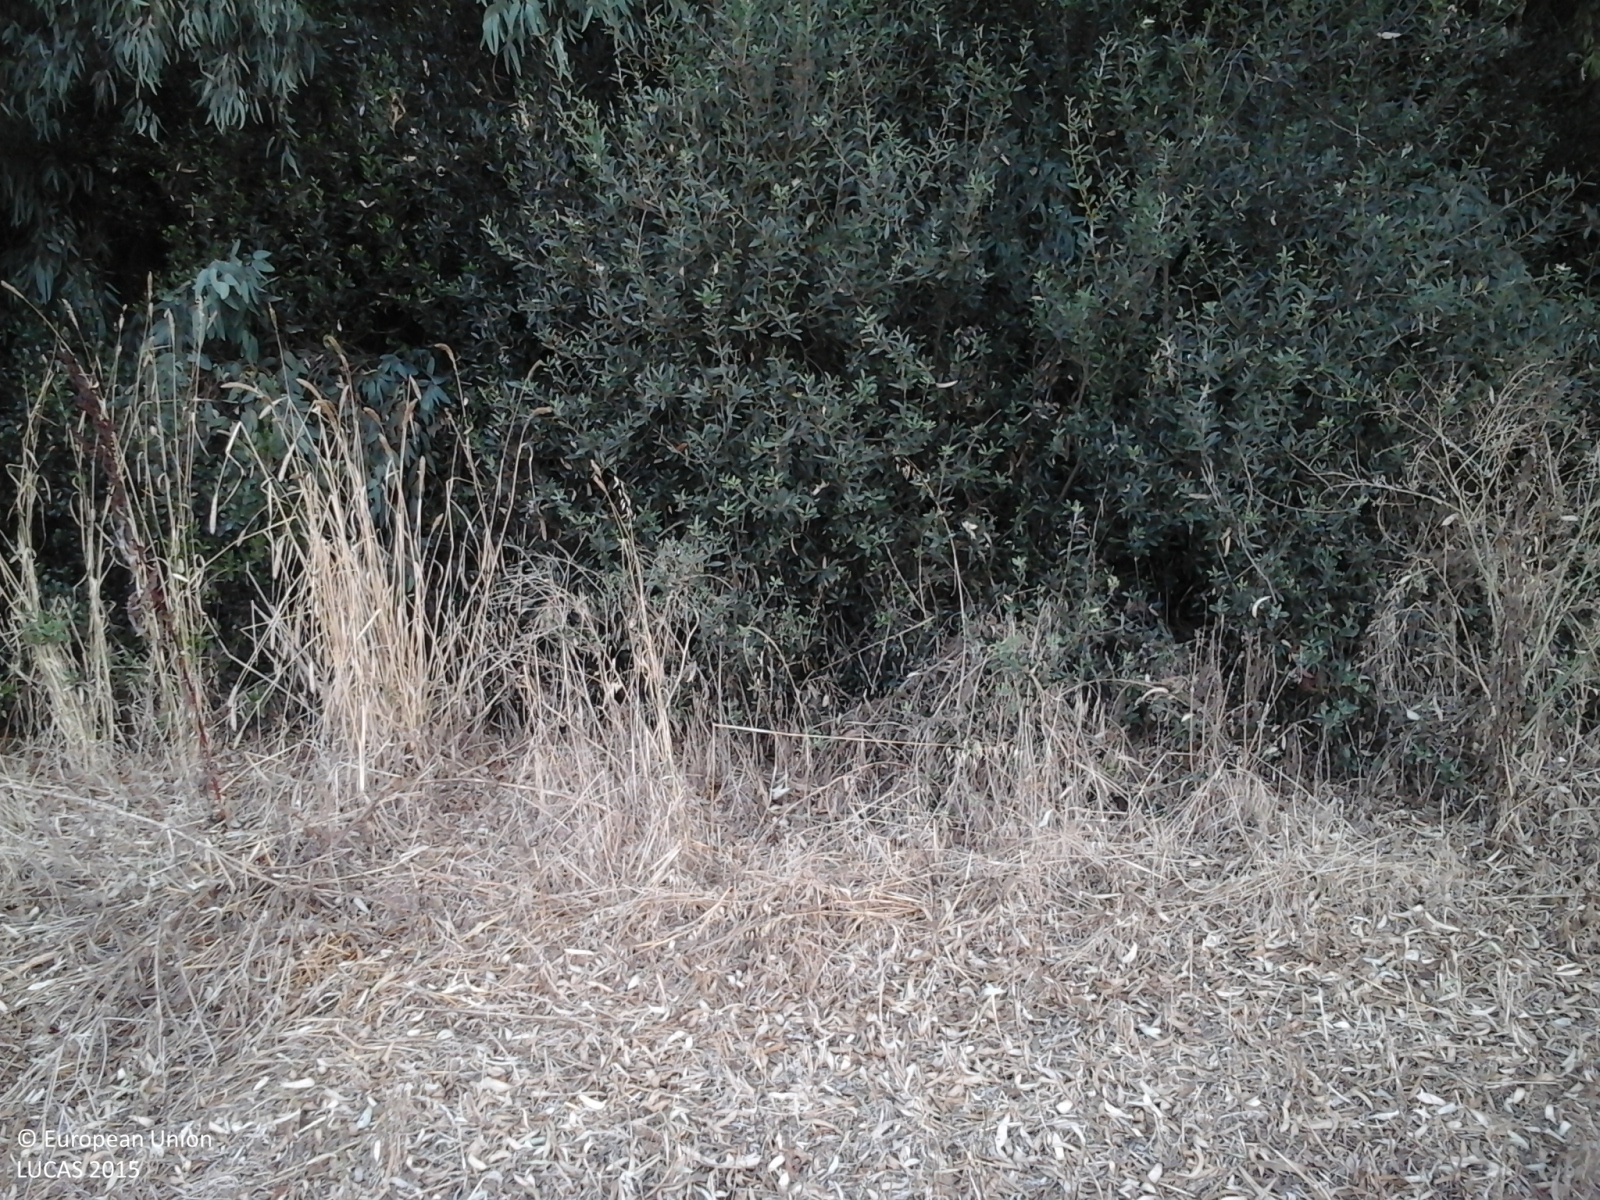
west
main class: Cropland
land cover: Temporary grasslands
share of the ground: > 75 %
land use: Agriculture (excluding fallow land and kitchen gardens)
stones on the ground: < 10 %
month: July
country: IT
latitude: 41.4762
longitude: 12.8029
